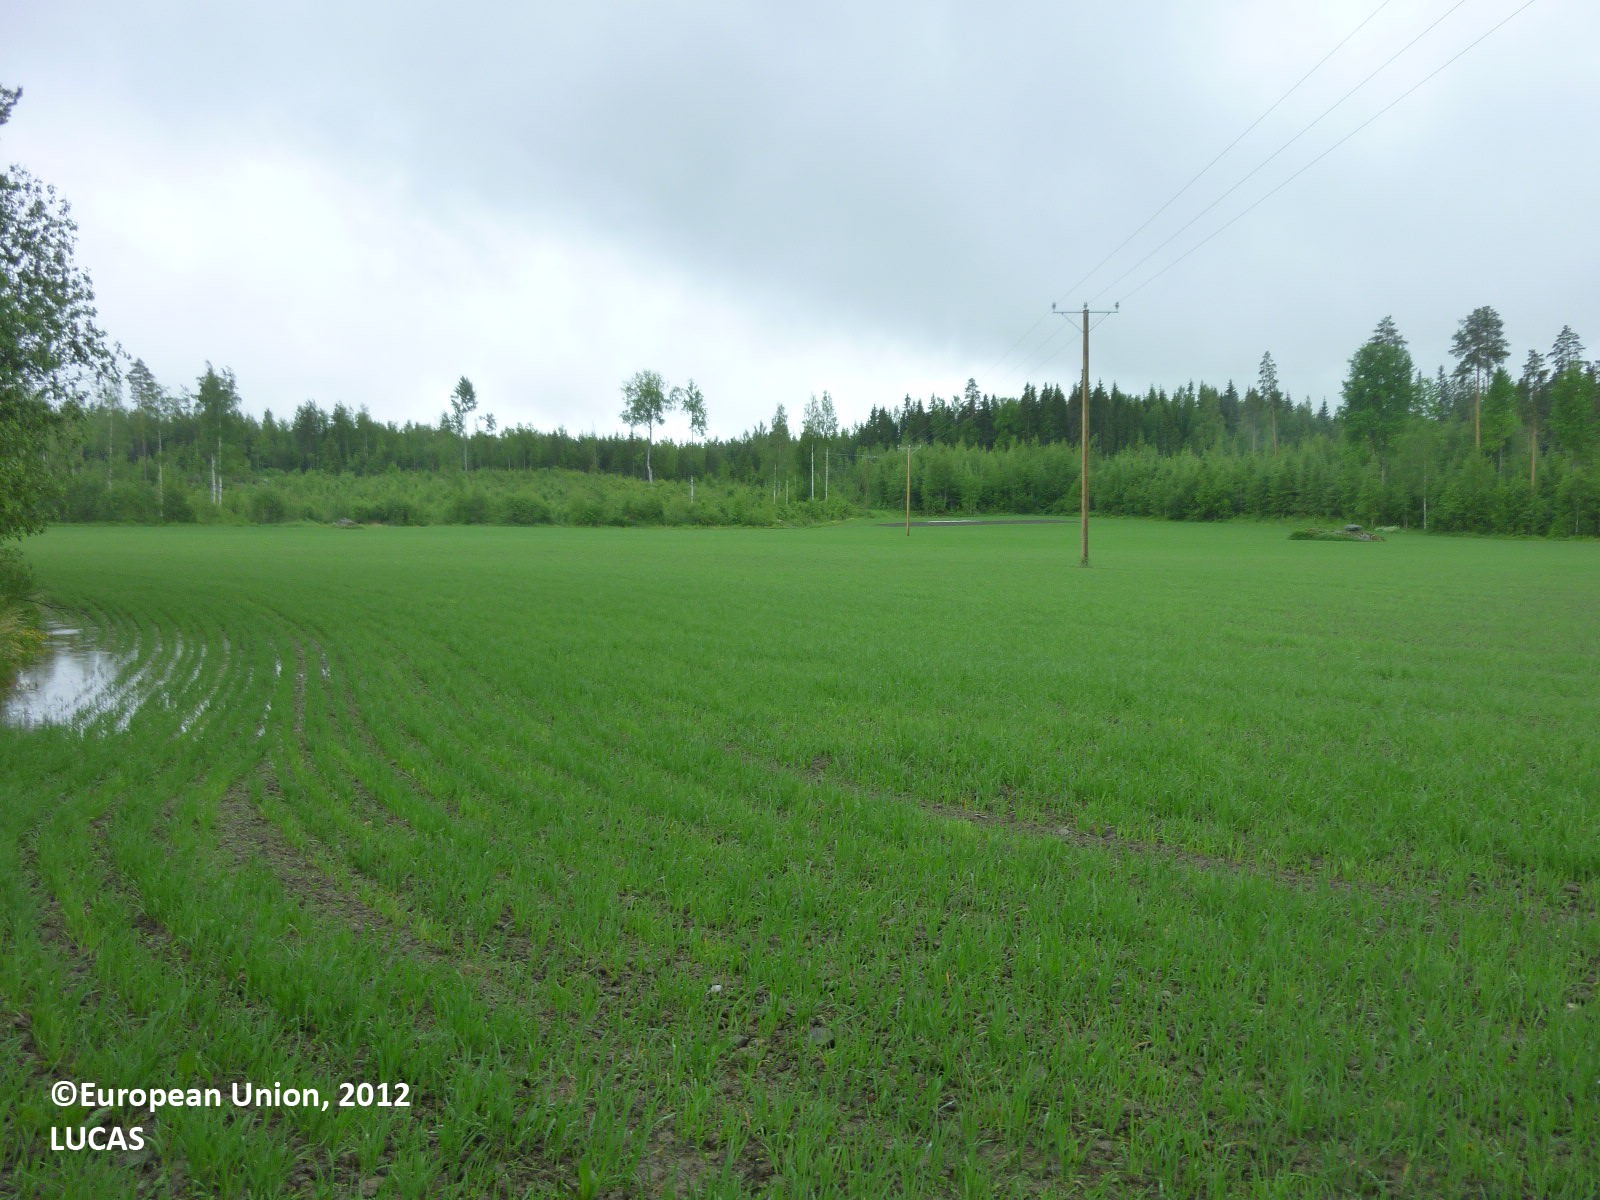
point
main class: Cropland
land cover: Oats
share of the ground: > 75 %
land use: Agriculture (excluding fallow land and kitchen gardens)
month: June
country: FI
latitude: 61.5387
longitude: 22.3058
